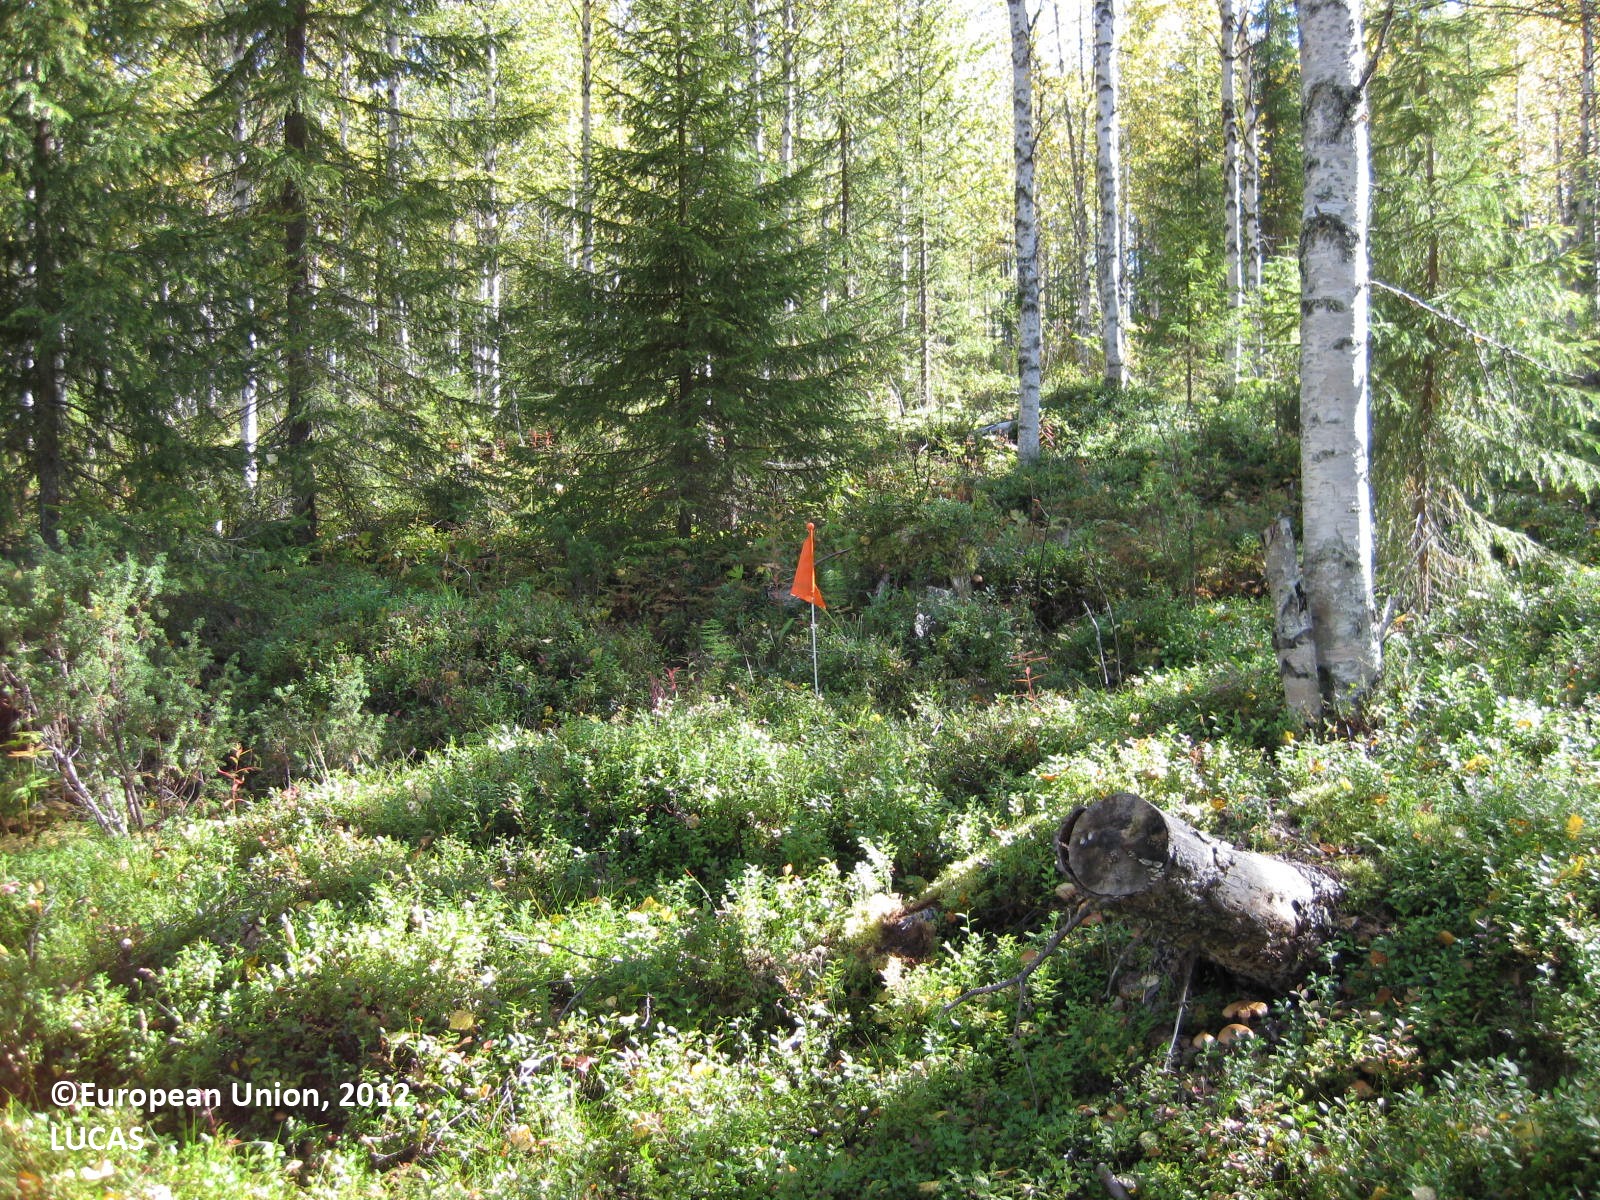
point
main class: Woodland
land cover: Broadleaved woodland
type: boreal forest
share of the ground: 50 - 75 %
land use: Forestry
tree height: > 5 m
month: August
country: FI
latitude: 65.8419
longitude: 28.6204
